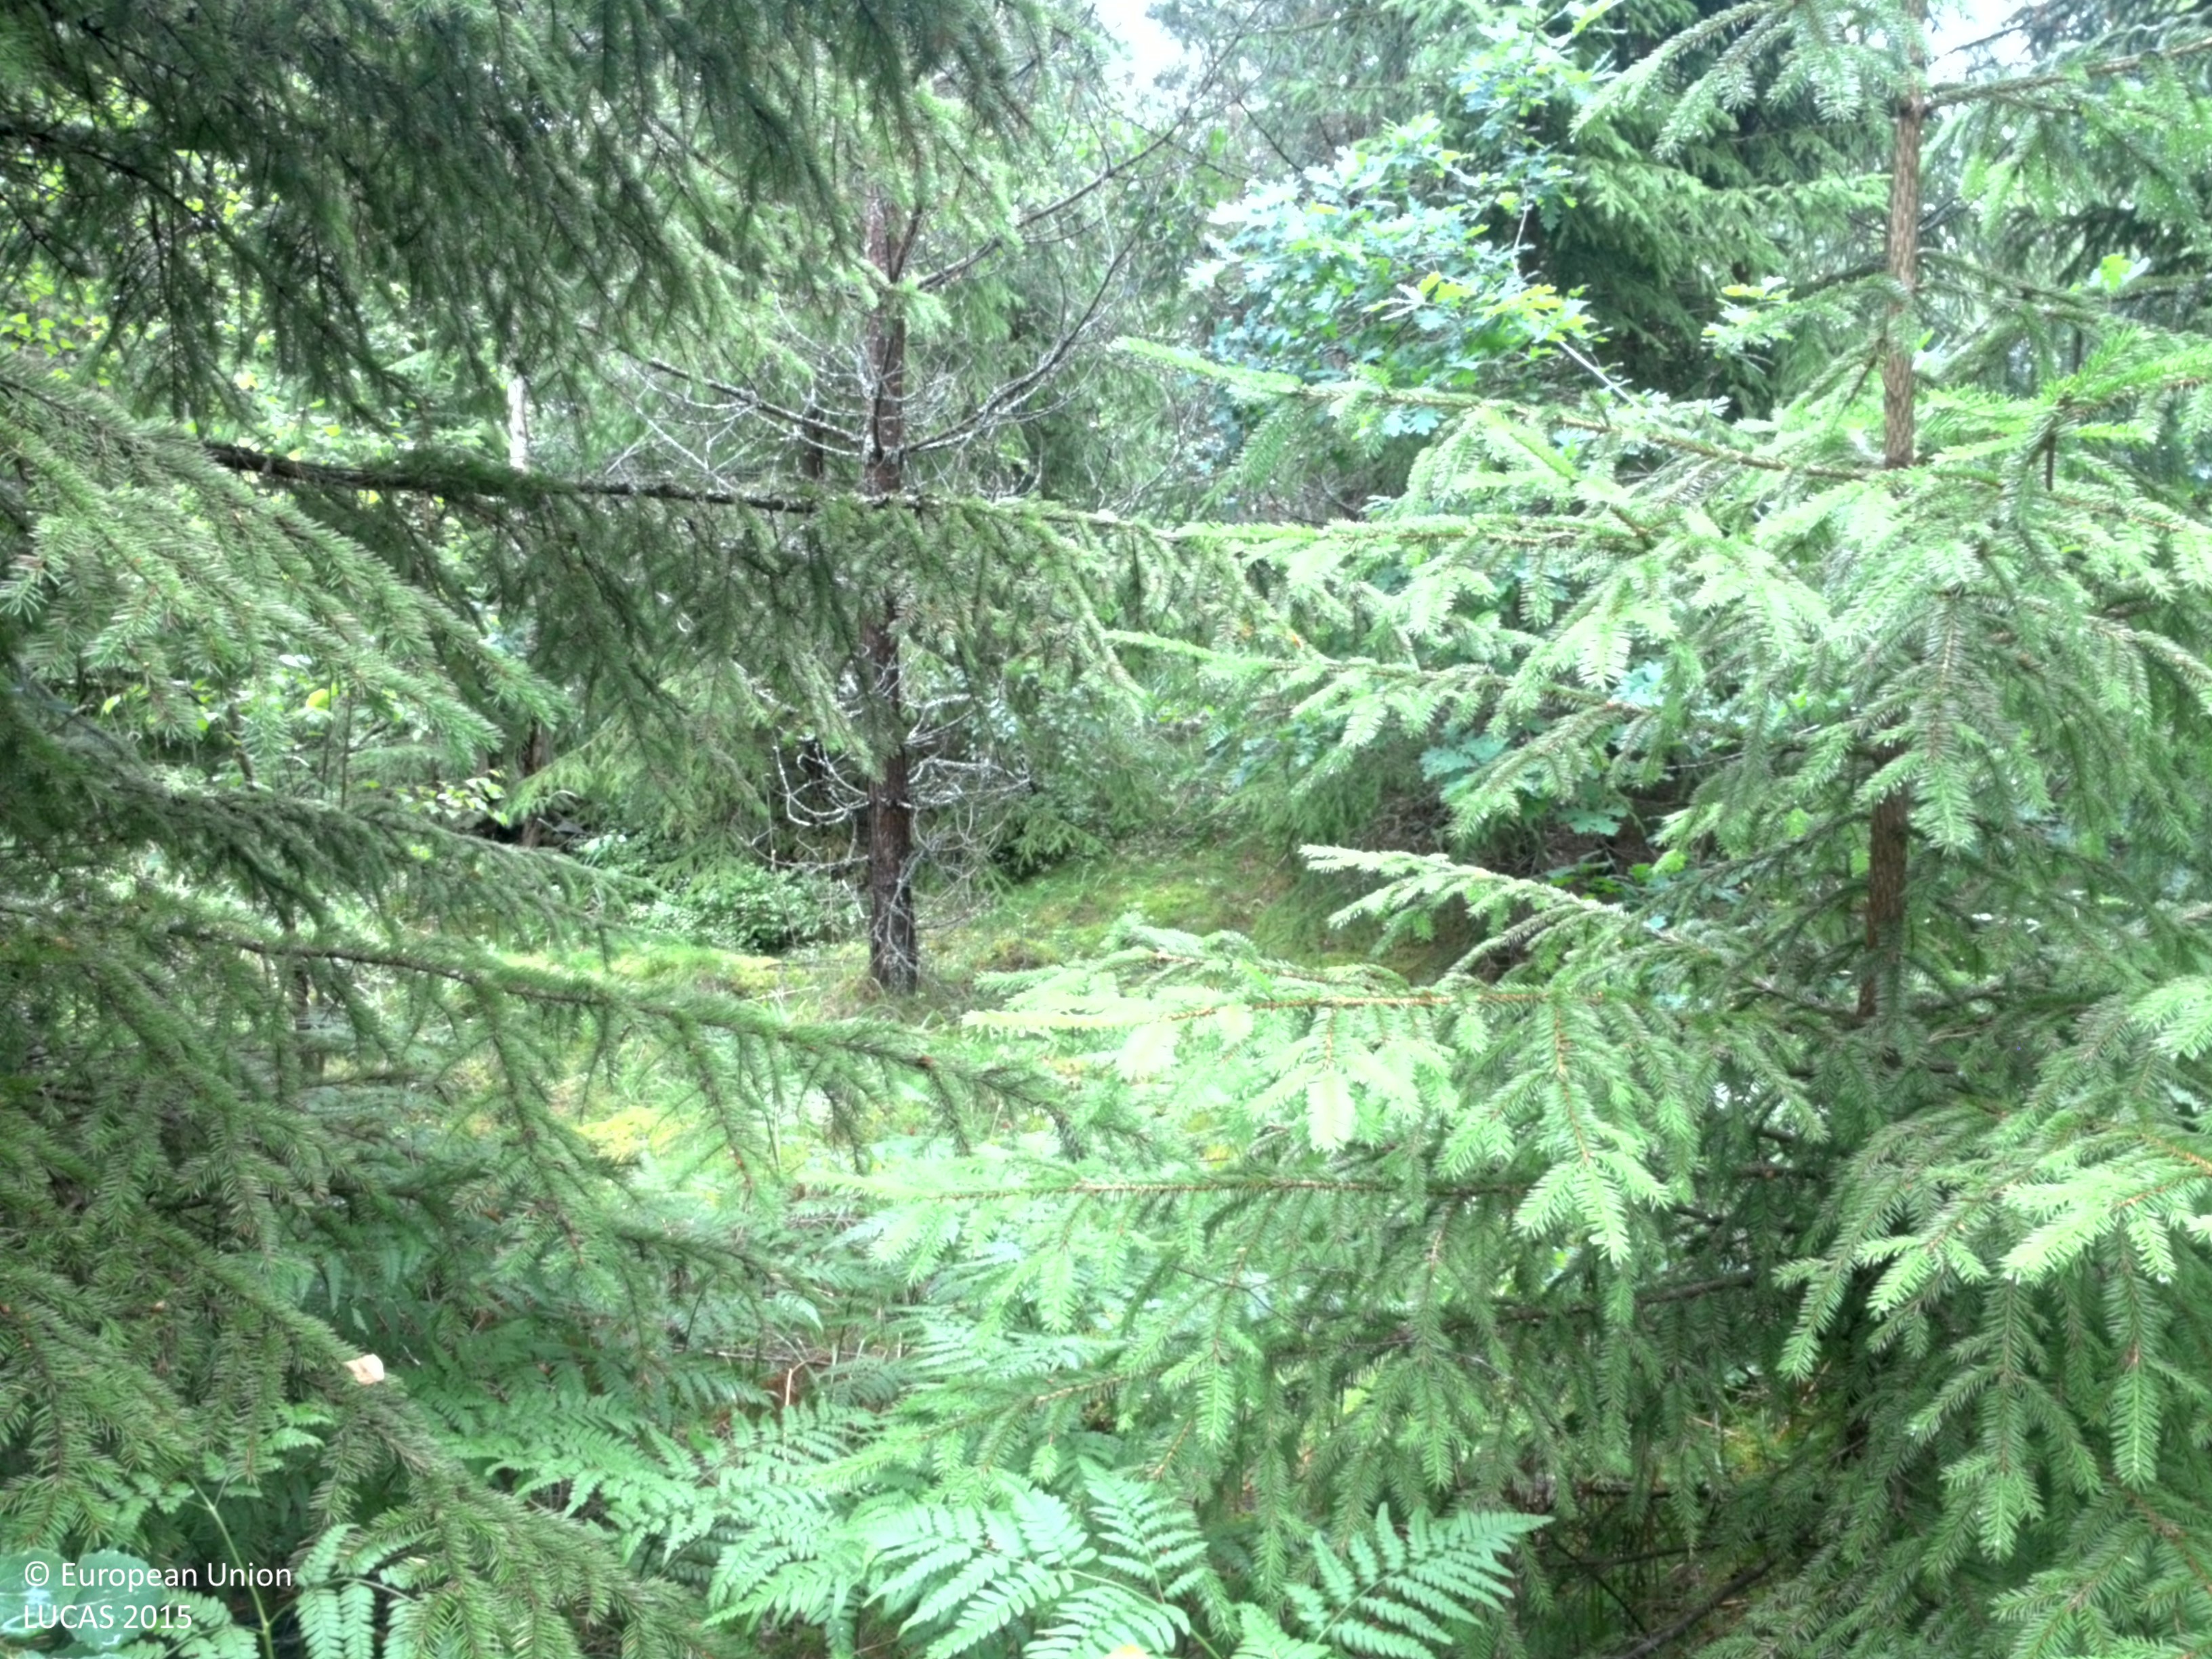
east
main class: Woodland
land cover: Other coniferous woodland
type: boreal forest
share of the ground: > 75 %
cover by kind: coniferous forest trees 60 %, broadleaved forest trees 20 %, herbaceous plants 20 %
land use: Forestry
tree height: > 5 m
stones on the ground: < 10 %
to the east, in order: Other coniferous woodland; Tracks; Other coniferous woodland; Tracks; Spruce dominated mixed woodland; Broadleaved woodland; Spruce dominated mixed woodland; Other coniferous woodland
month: July
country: SE
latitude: 60.1587
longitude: 17.2162
